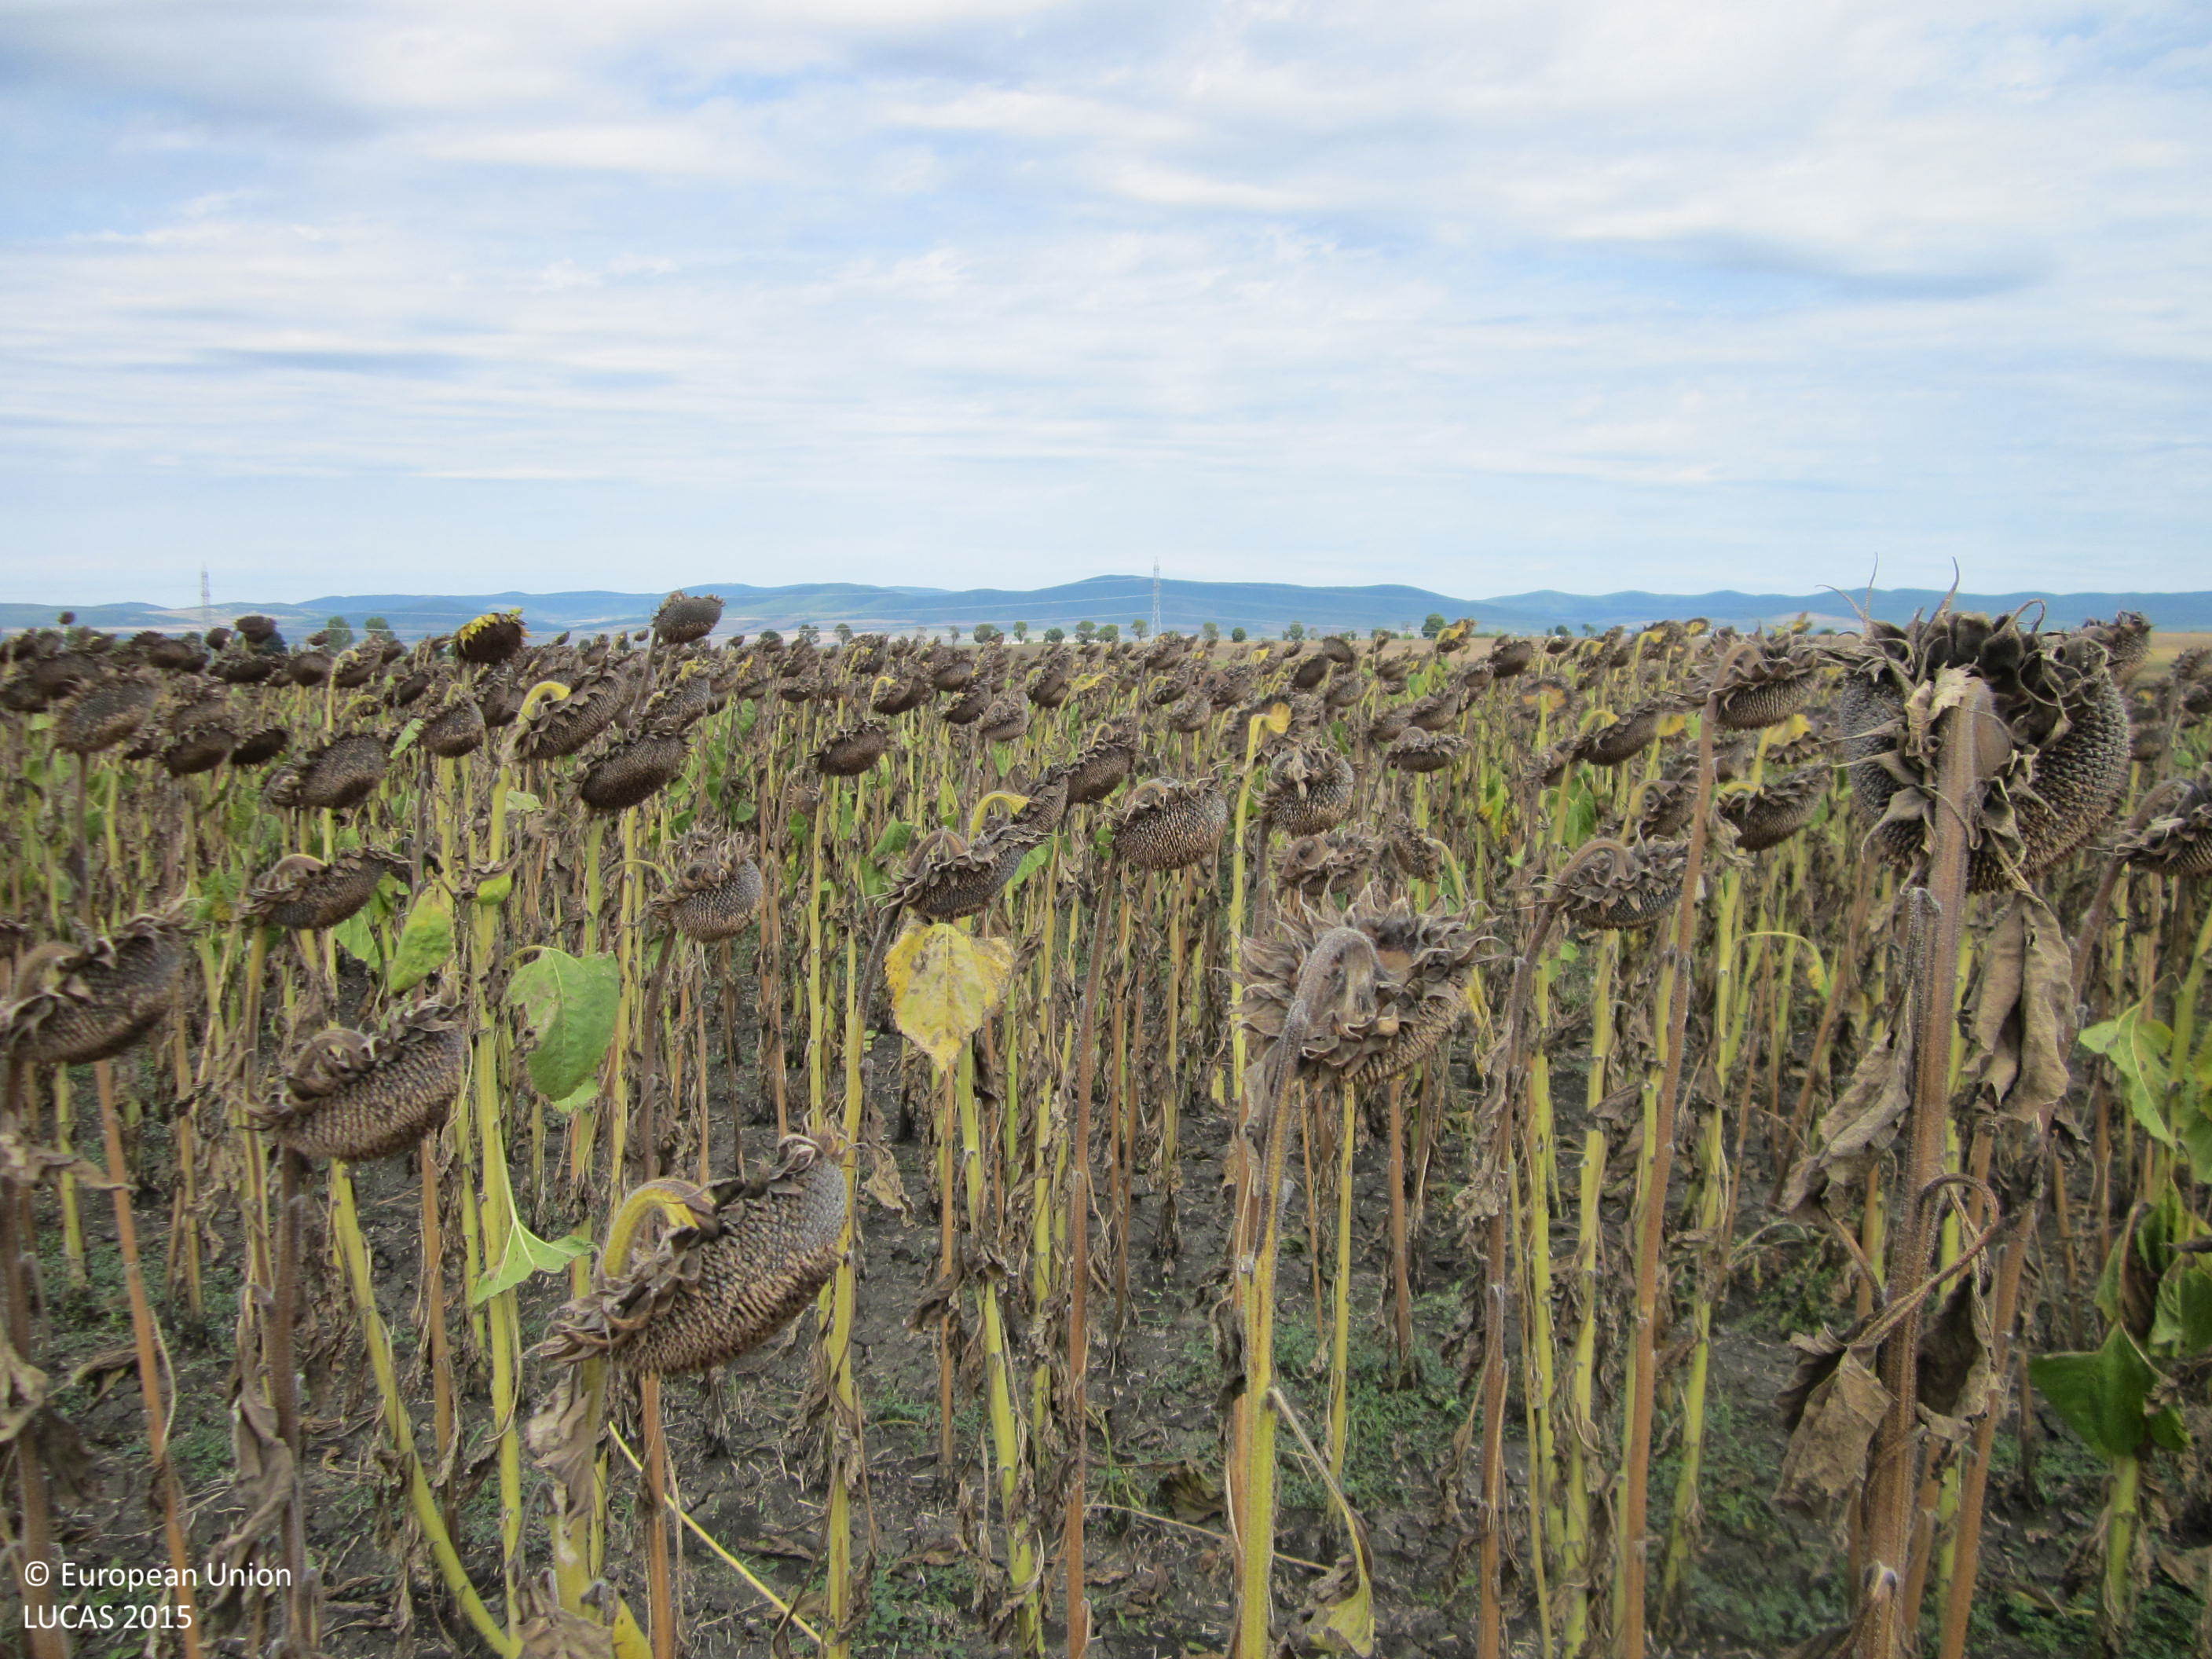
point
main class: Cropland
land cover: Sunflower
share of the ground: > 75 %
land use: Agriculture (excluding fallow land and kitchen gardens)
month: September
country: BG
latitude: 42.6546
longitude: 27.0269
